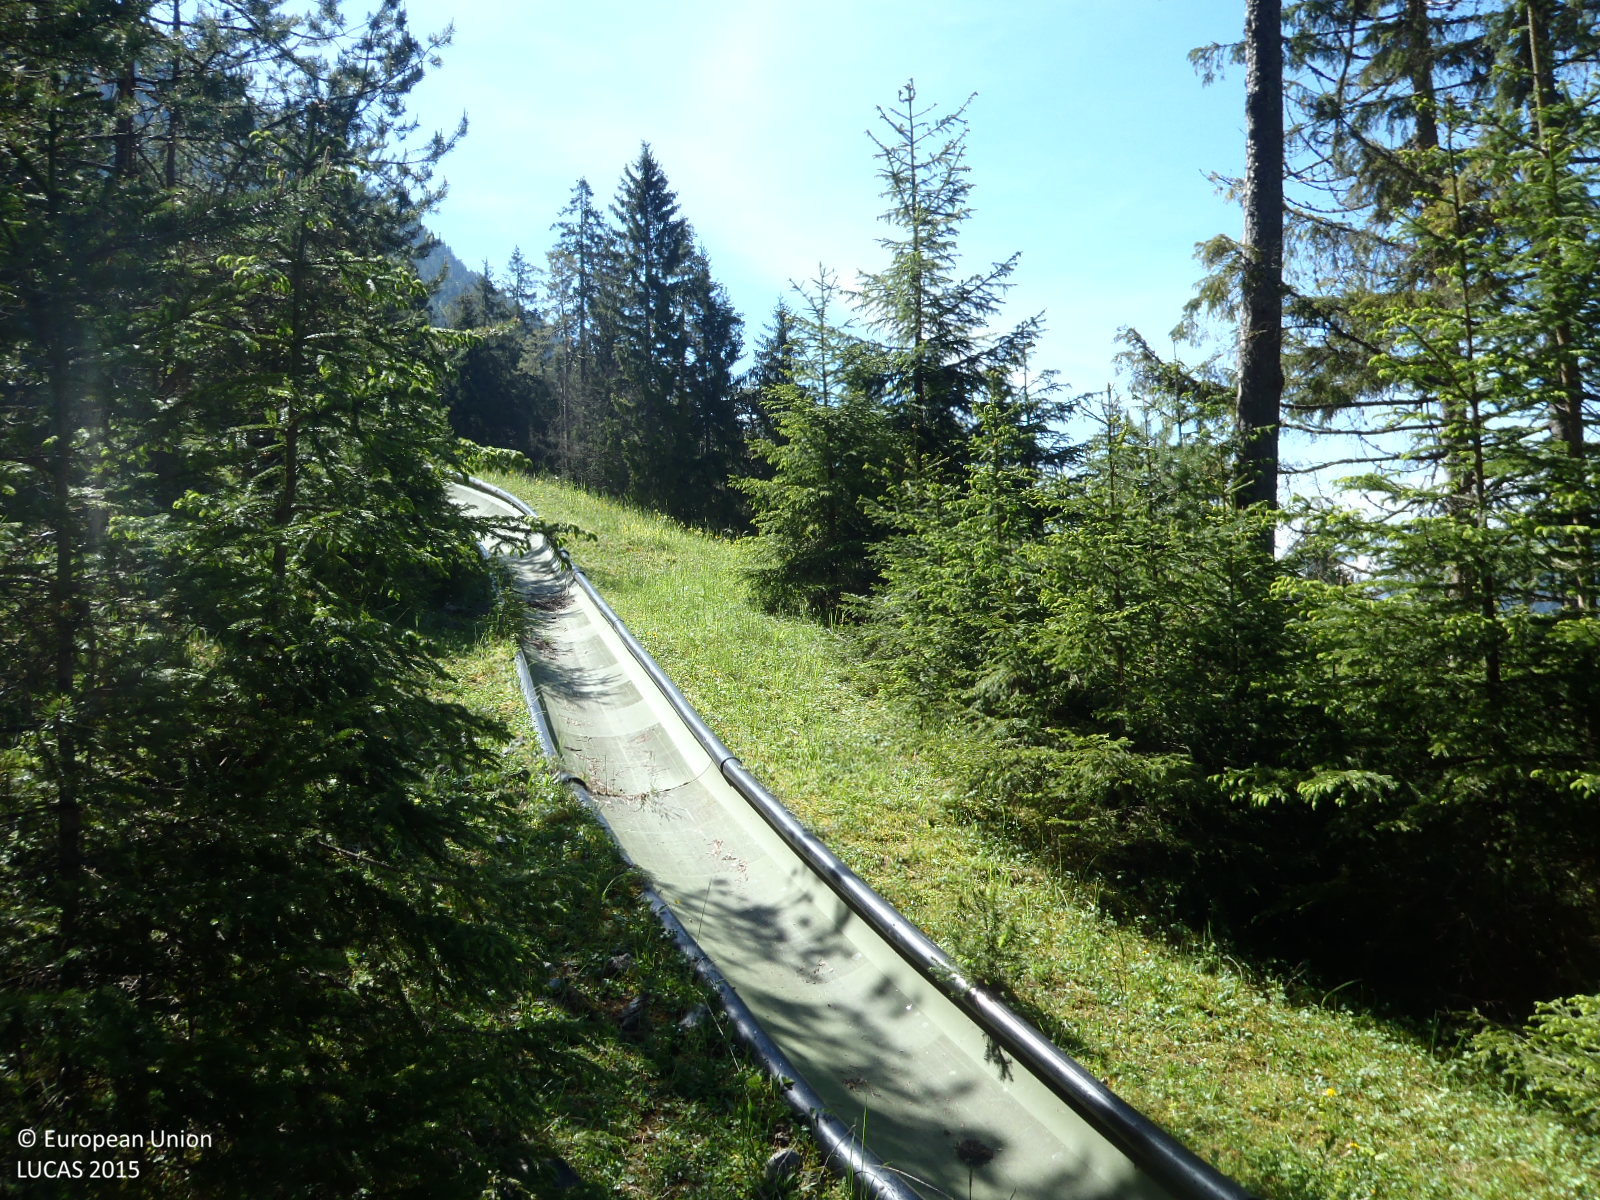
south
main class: Woodland
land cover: Pine dominated coniferous woodland
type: alpine coniferous forest
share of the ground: > 75 %
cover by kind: coniferous forest trees 90 %, herbaceous plants 5 %, unconsolidated bare surface 5 %
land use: Forestry
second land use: Agriculture (excluding fallow land and kitchen gardens)
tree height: > 5 m
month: May
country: AT
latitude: 47.5262
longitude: 11.7120
